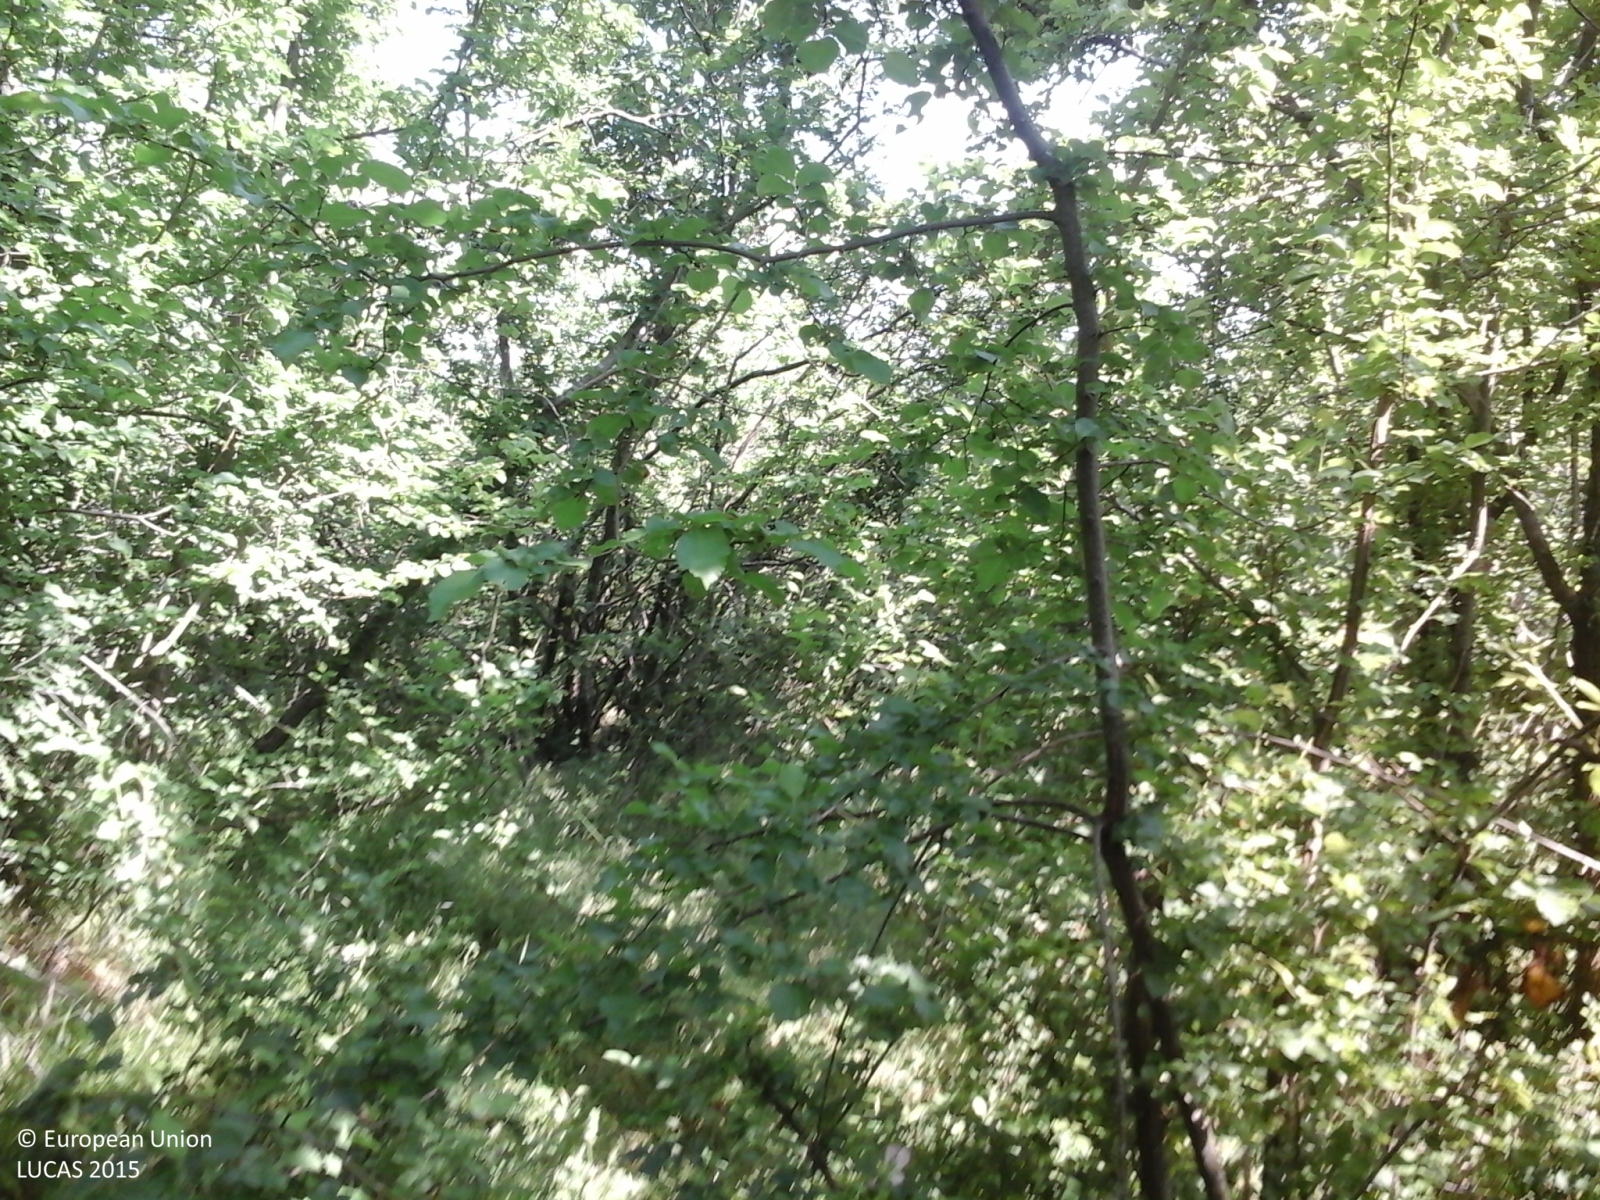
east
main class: Woodland
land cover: Broadleaved woodland
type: thermophilous deciduous forest
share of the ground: > 75 %
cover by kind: broadleaved forest trees 100 %
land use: Forestry
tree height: > 5 m
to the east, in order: Broadleaved woodland; Electric lines; Broadleaved woodland; Grassland without tree/shrub cover; Shrubland with sparse tree cover; Common wheat; Grassland without tree/shrub cover
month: May
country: IT
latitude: 44.2003
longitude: 11.1110
